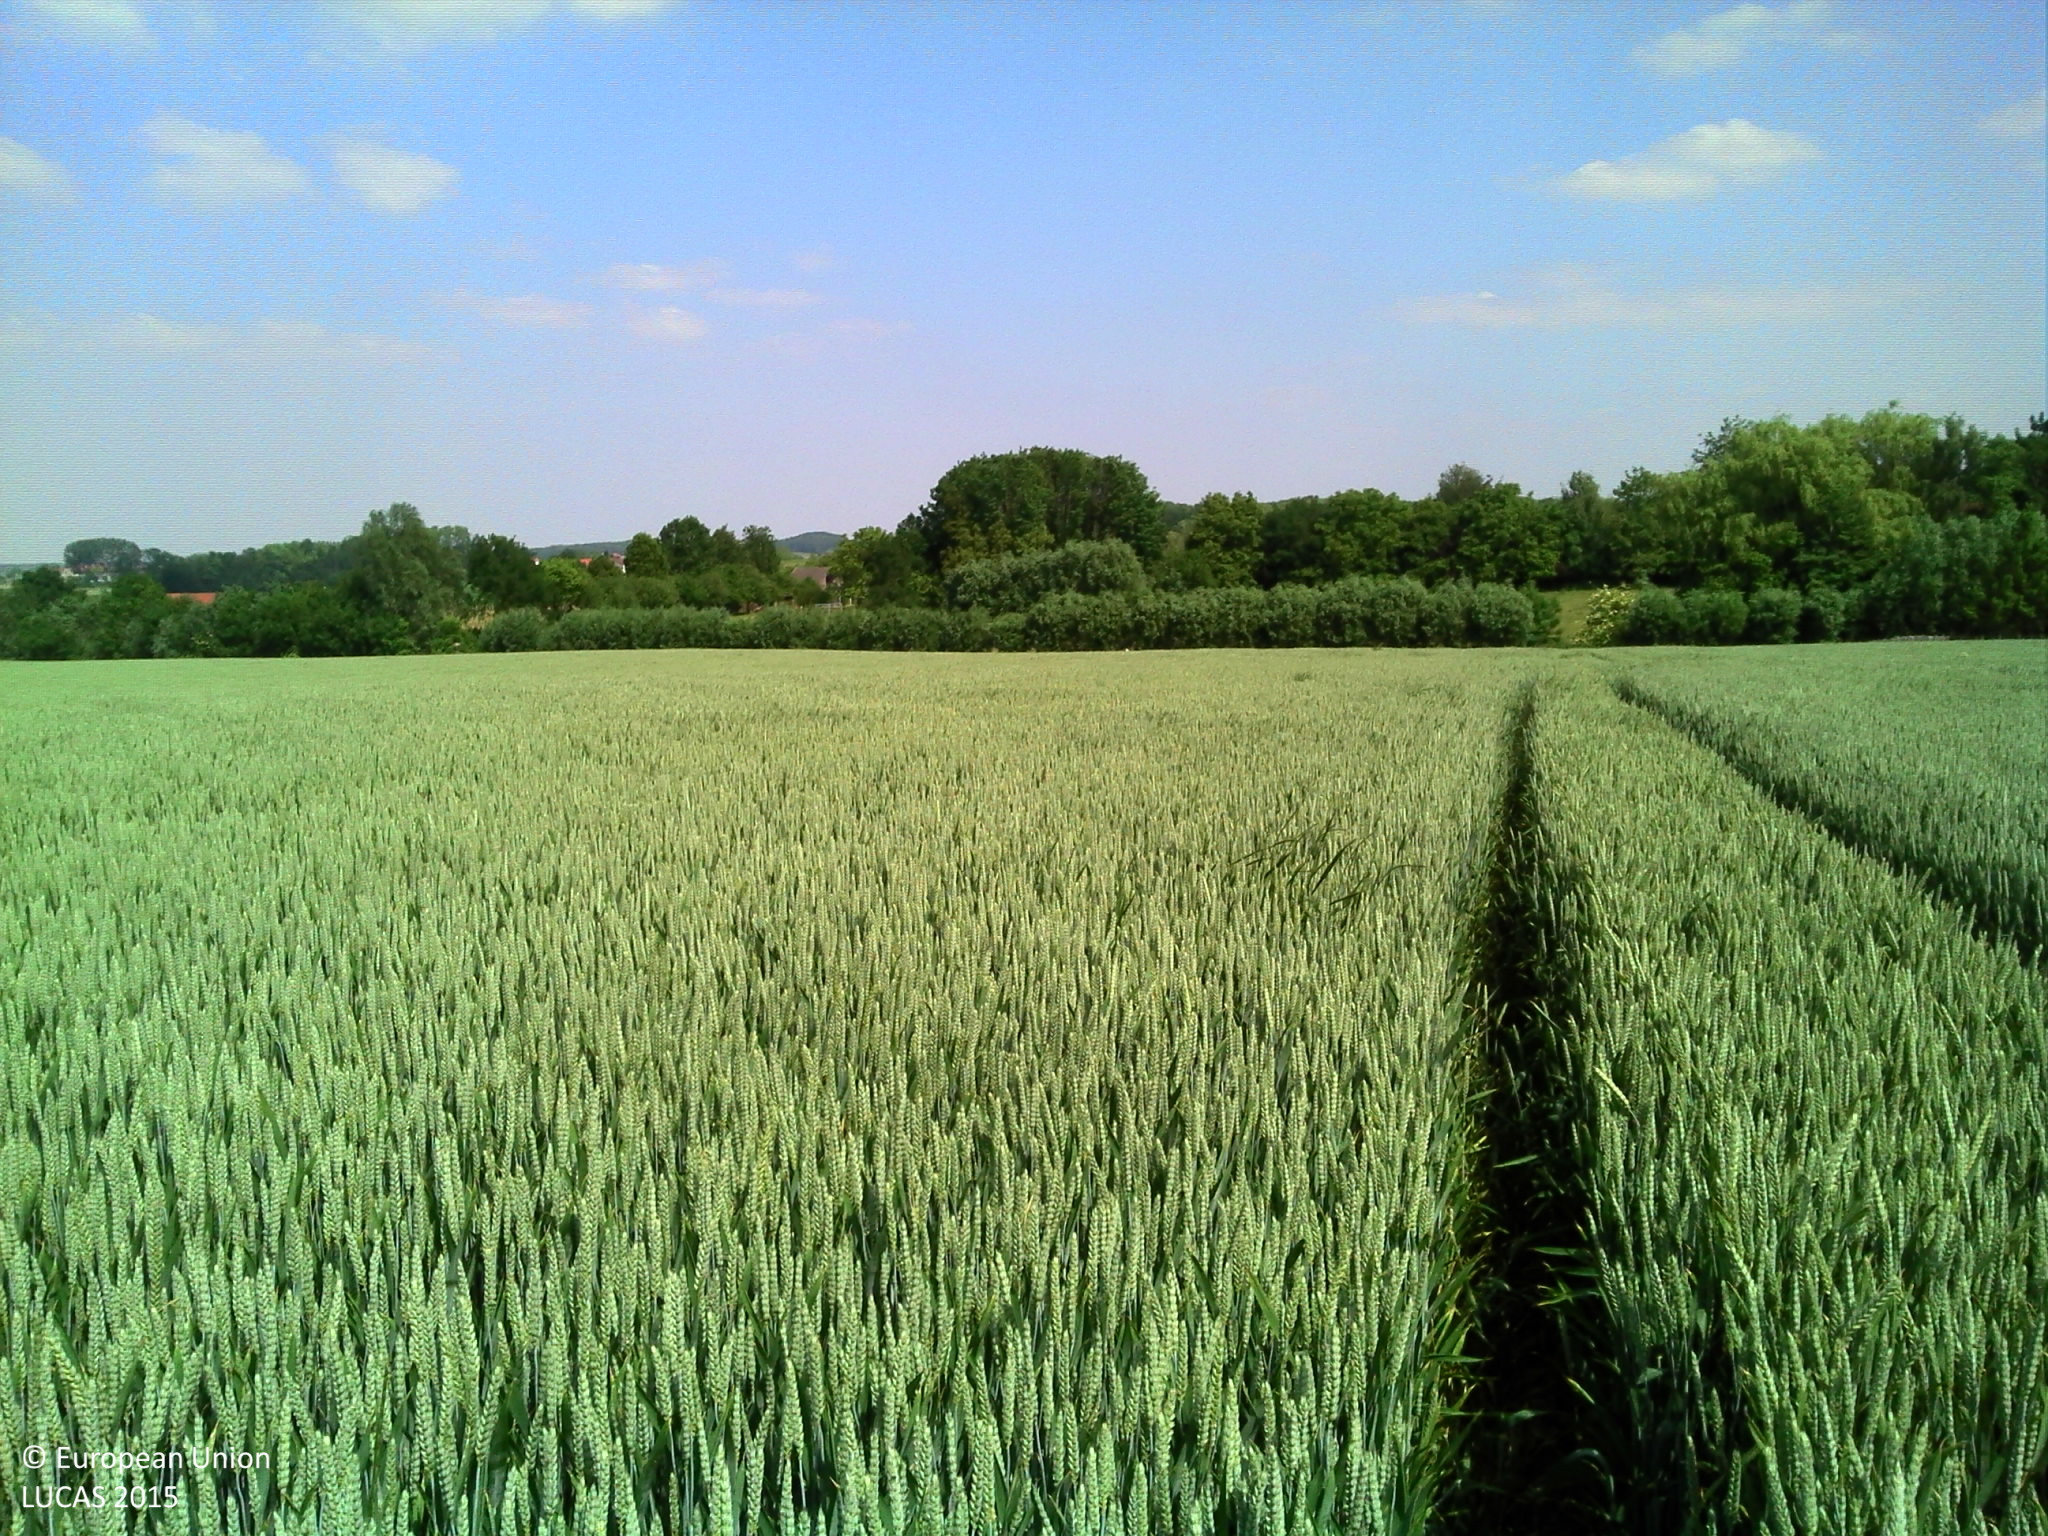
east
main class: Cropland
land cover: Common wheat
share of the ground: > 75 %
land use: Agriculture (excluding fallow land and kitchen gardens)
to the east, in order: Common wheat; Grass margins; Lines of trees; Ditches and canals; Grass margins; Fences; Grassland without tree/shrub cover; Broadleaved woodland; Grassland without tree/shrub cover
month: June
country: BE
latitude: 50.7885
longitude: 2.8255
